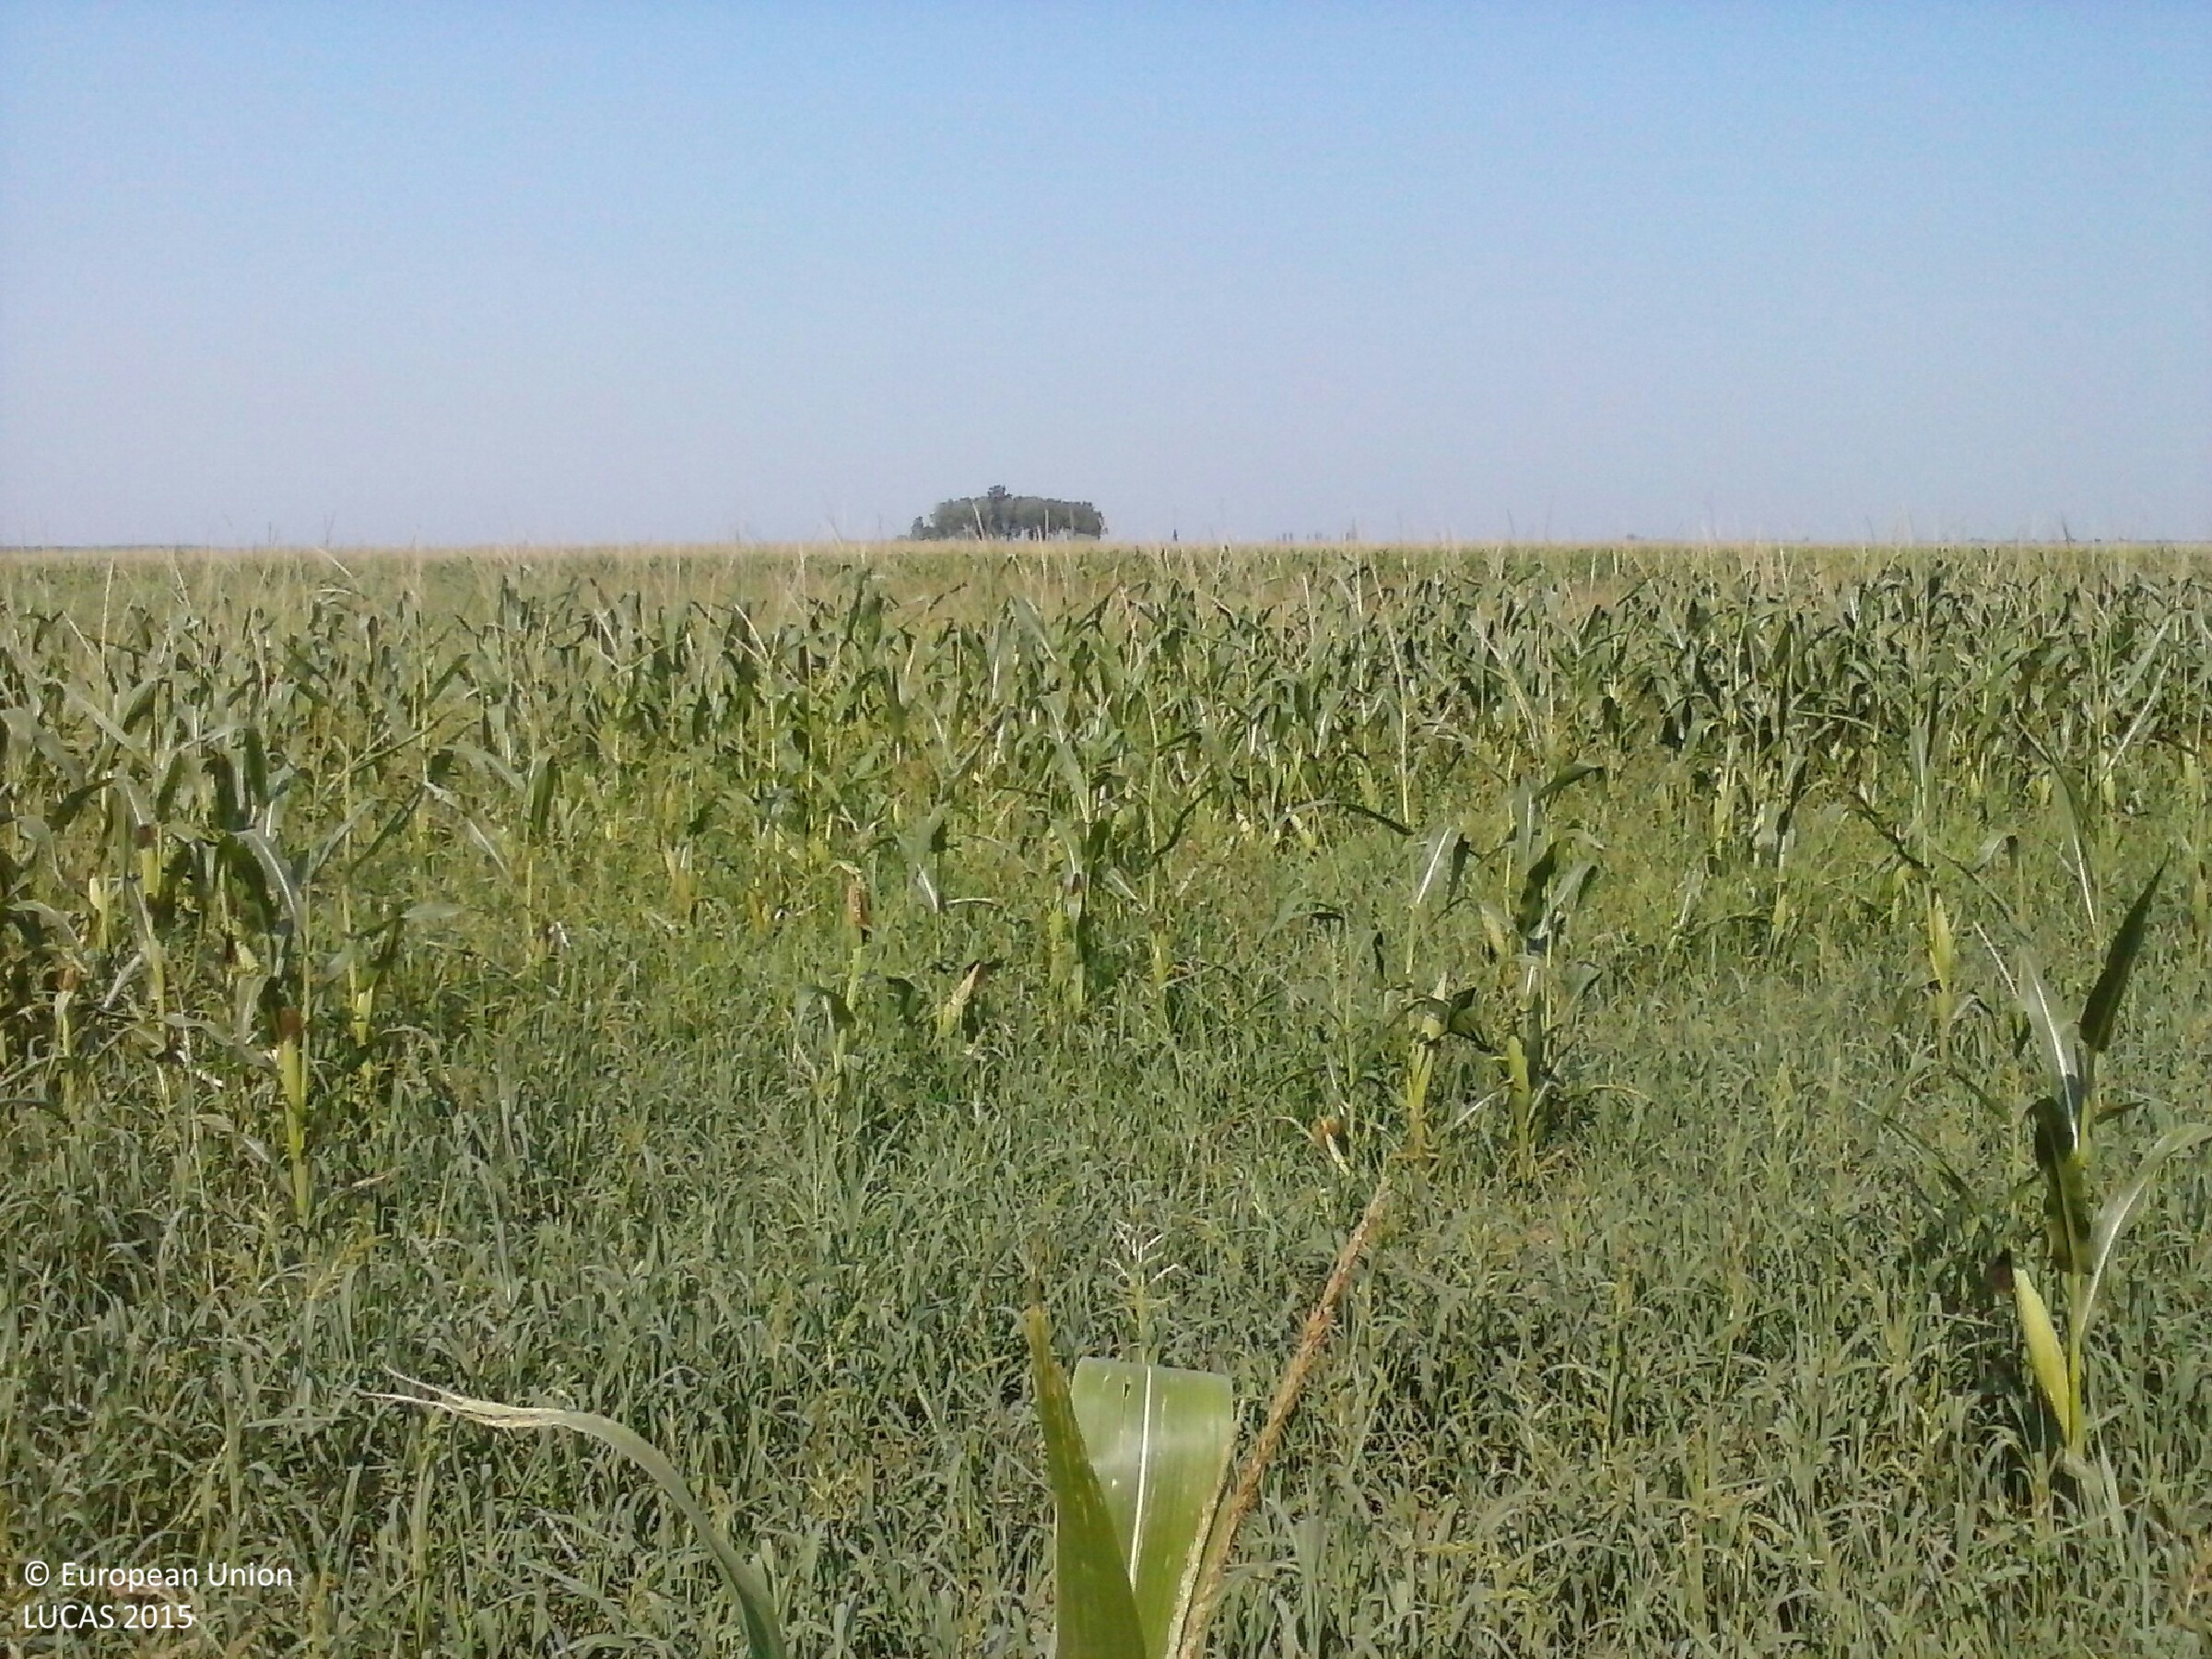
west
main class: Cropland
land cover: Maize
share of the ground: 25 - 50 %
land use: Agriculture (excluding fallow land and kitchen gardens)
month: August
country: HU
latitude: 45.9850
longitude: 17.9184
